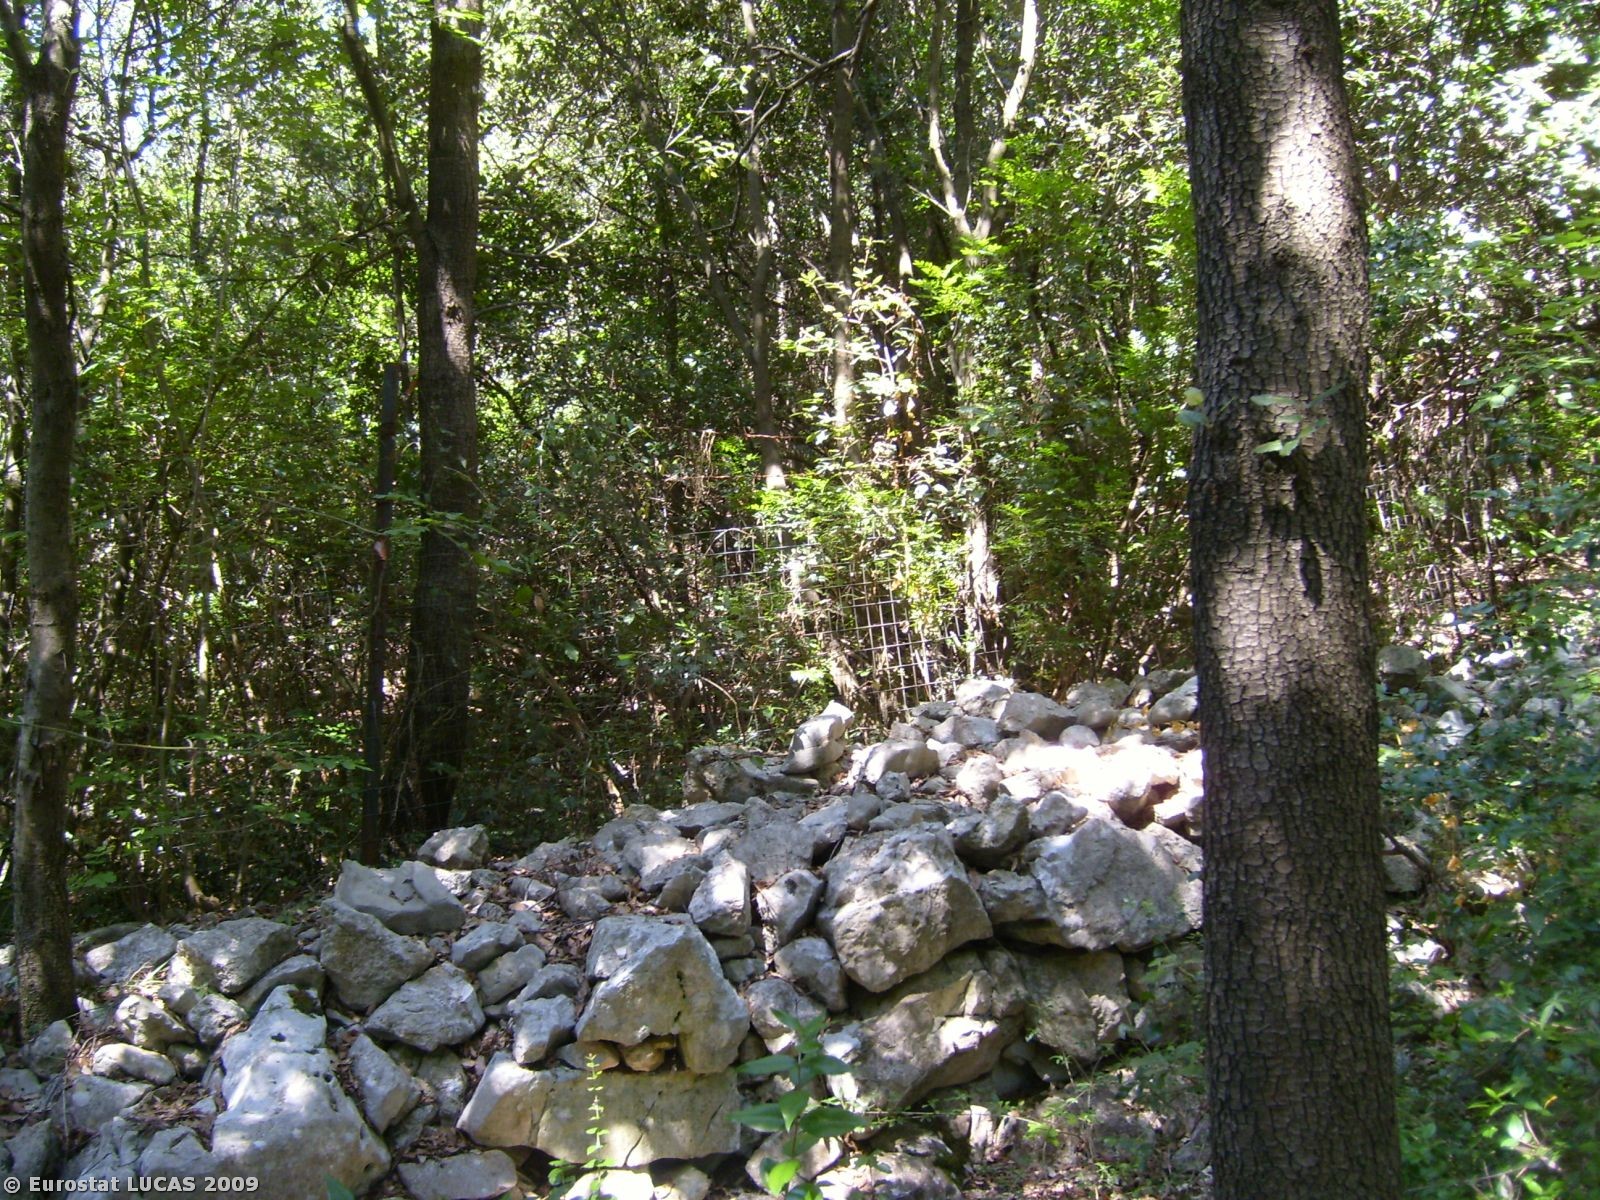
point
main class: Woodland
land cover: Broadleaved woodland
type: thermophilous deciduous forest
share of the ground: > 75 %
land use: Forestry
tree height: > 5 m
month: July
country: IT
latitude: 41.2221
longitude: 14.3372
